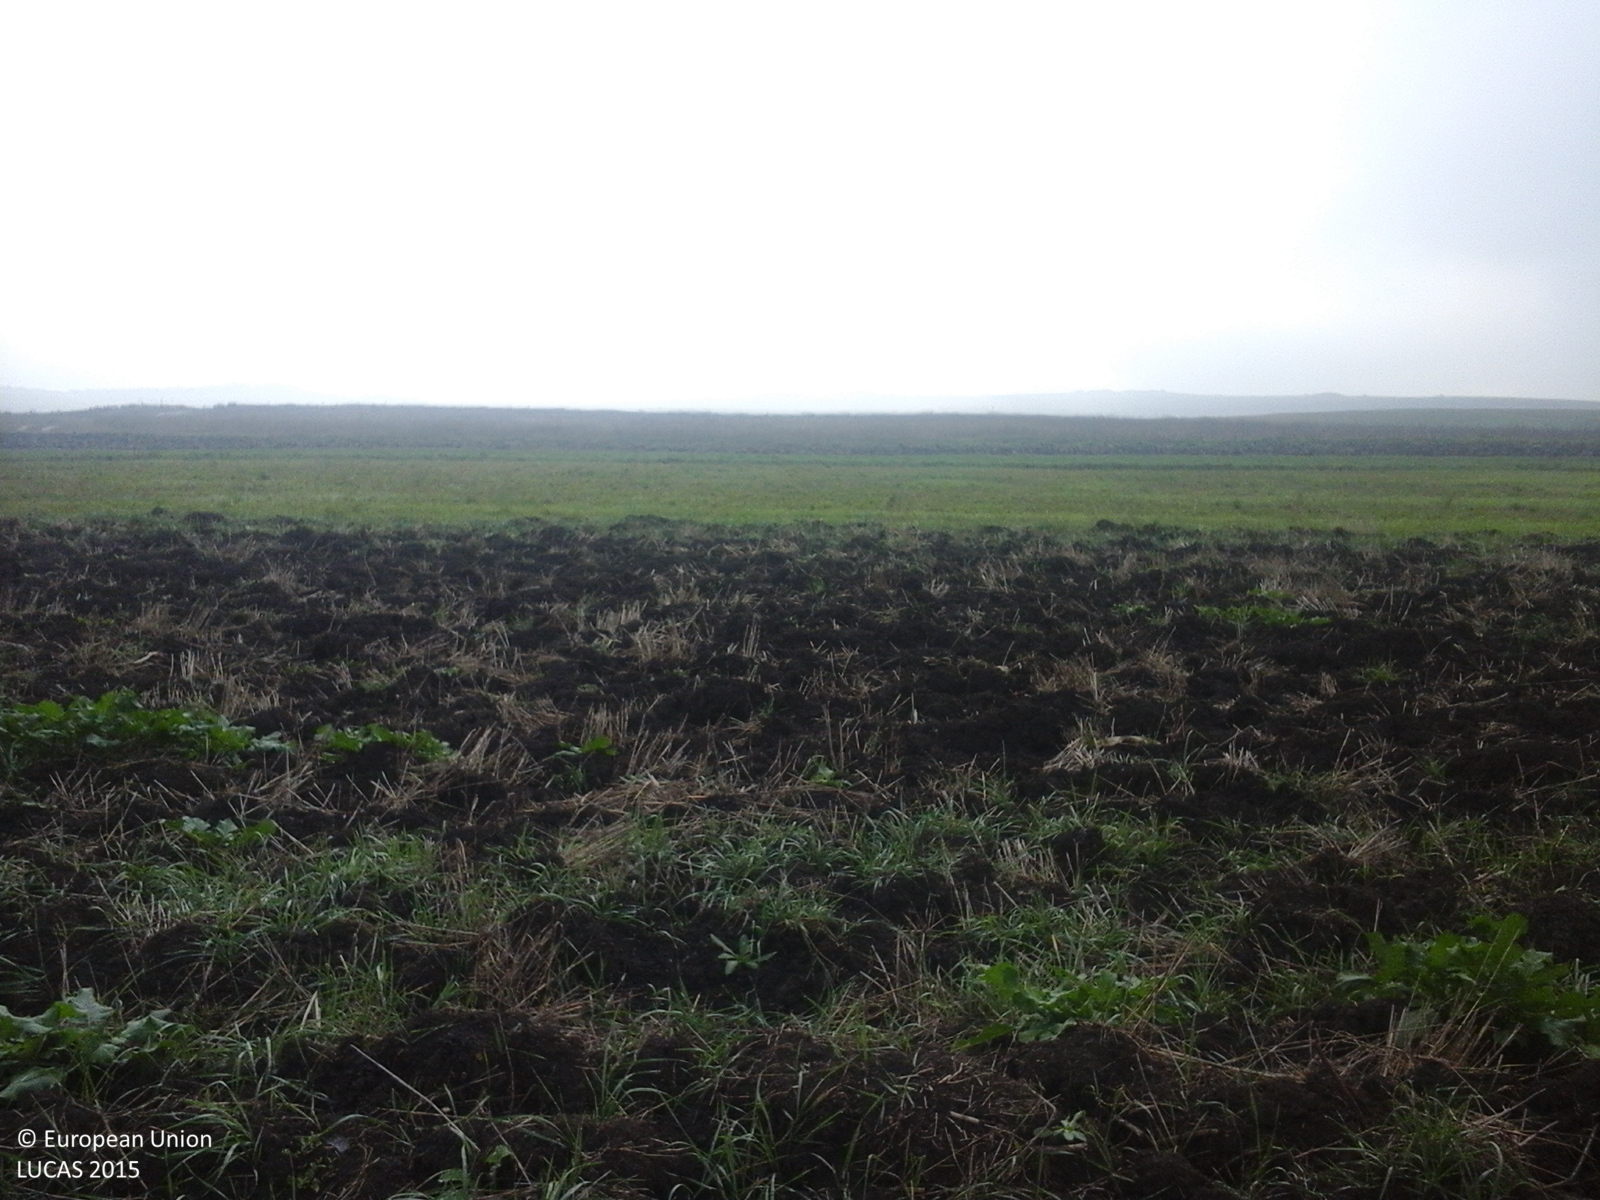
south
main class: Cropland
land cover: Lucerne
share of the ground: > 75 %
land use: Agriculture (excluding fallow land and kitchen gardens)
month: October
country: RO
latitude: 46.5279
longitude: 24.3595
